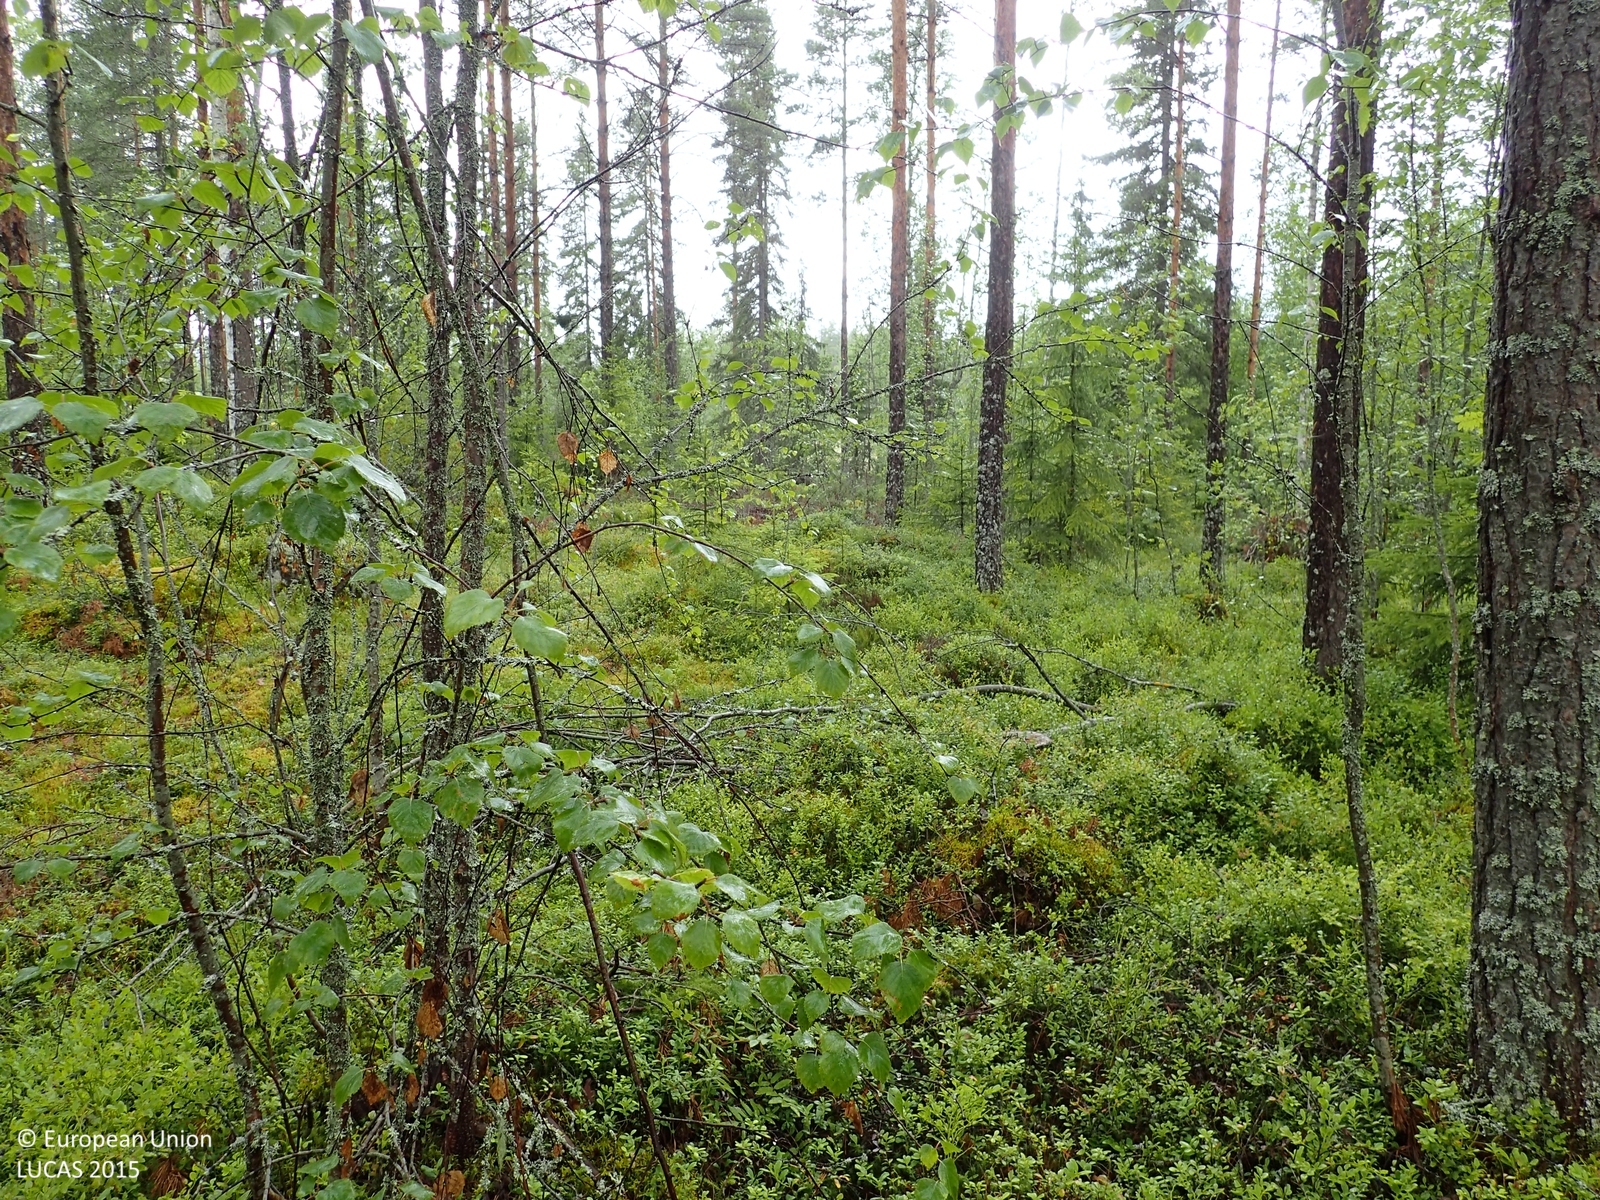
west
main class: Woodland
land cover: Pine dominated coniferous woodland
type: boreal forest
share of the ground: 50 - 75 %
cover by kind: coniferous forest trees 45 %, shrubs 40 %, broadleaved forest trees 10 %, lichens and mosses 5 %
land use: Forestry
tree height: > 5 m
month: July
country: FI
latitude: 63.0193
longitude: 22.7585
